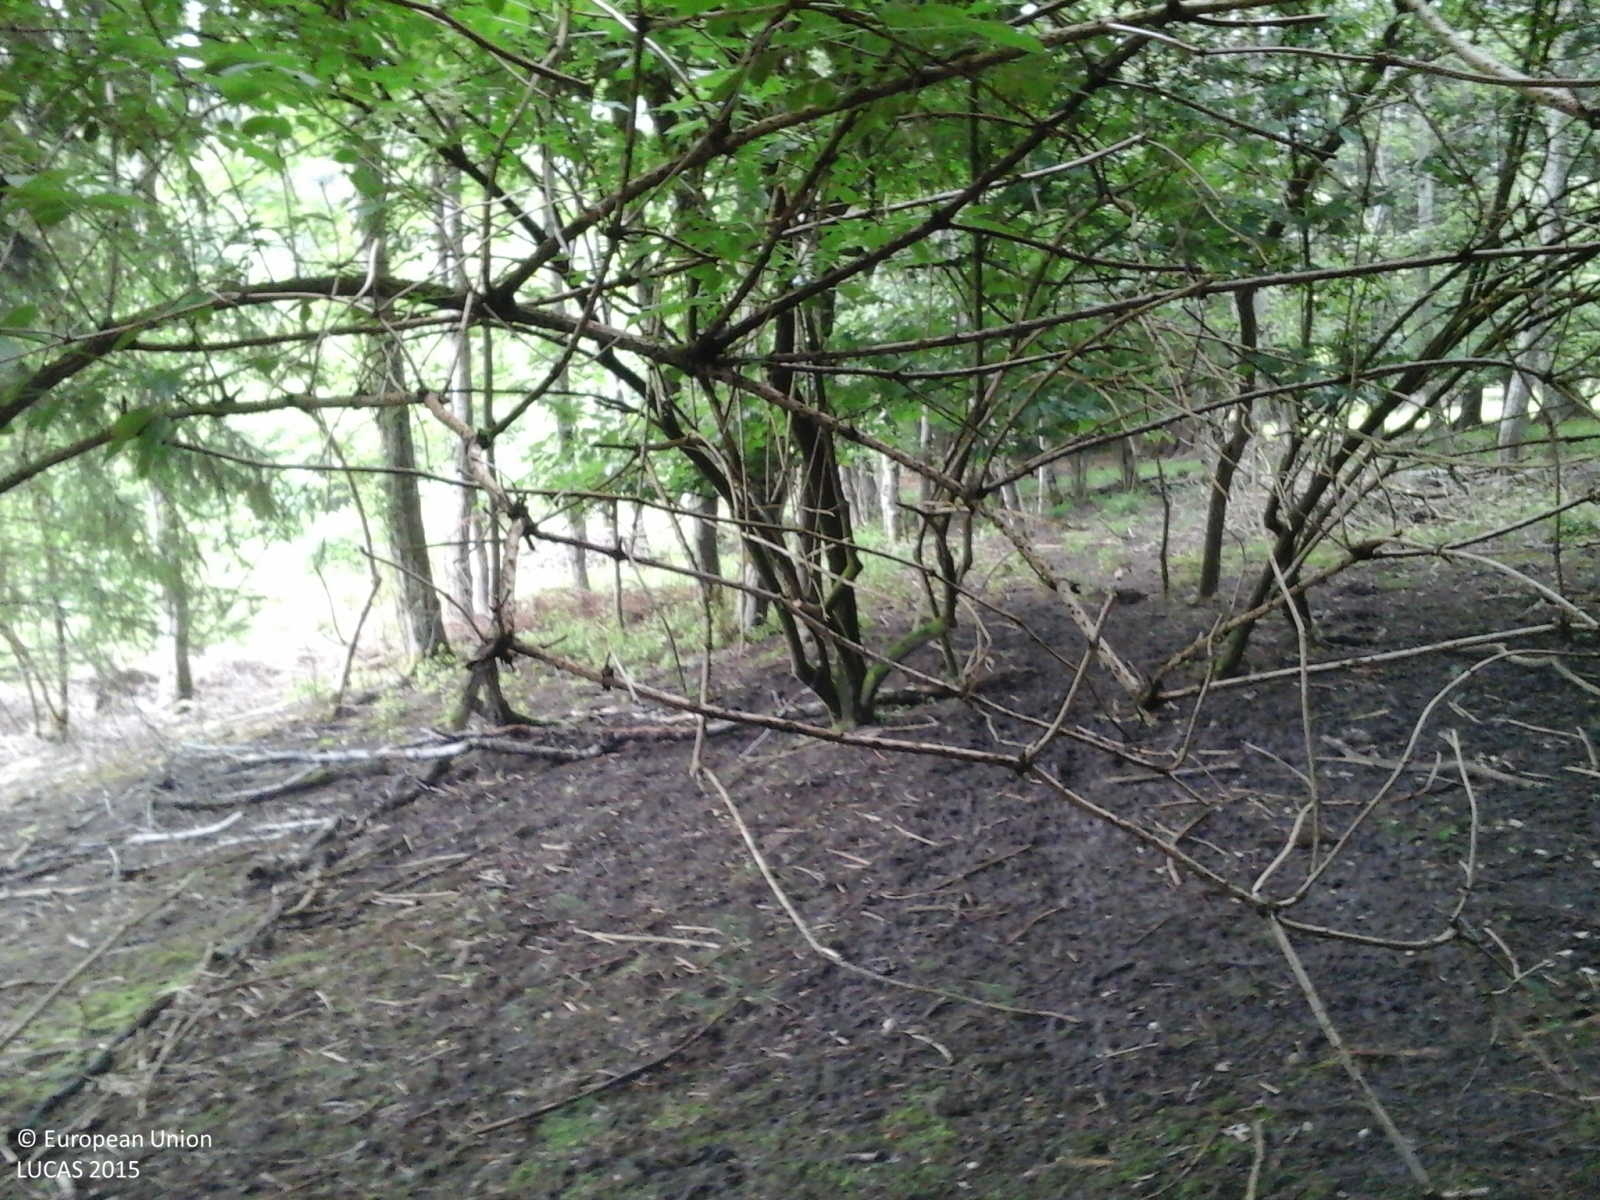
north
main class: Woodland
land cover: Other mixed woodland
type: alpine coniferous forest
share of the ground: > 75 %
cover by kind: broadleaved forest trees 60 %, coniferous forest trees 40 %
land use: Forestry
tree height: > 5 m
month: May
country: IT
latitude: 46.0504
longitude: 11.6391
